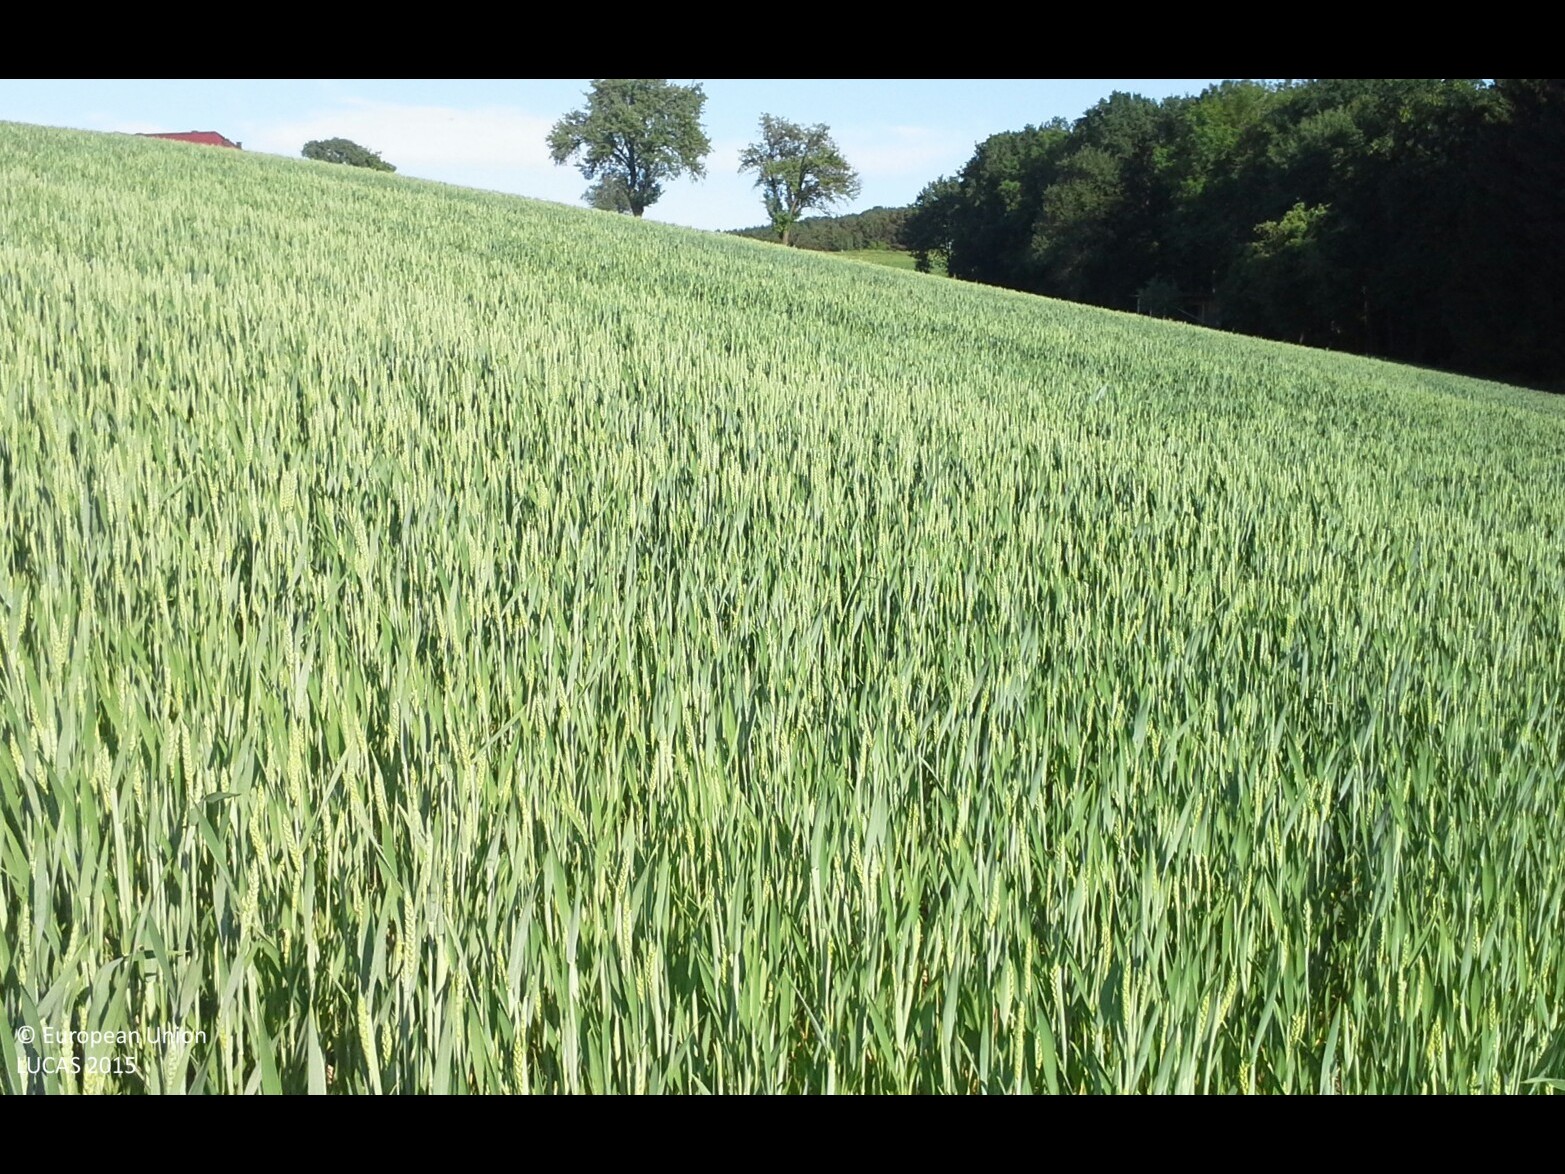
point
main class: Cropland
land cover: Common wheat
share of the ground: > 75 %
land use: Agriculture (excluding fallow land and kitchen gardens)
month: June
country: AT
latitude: 48.1227
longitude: 14.7160
